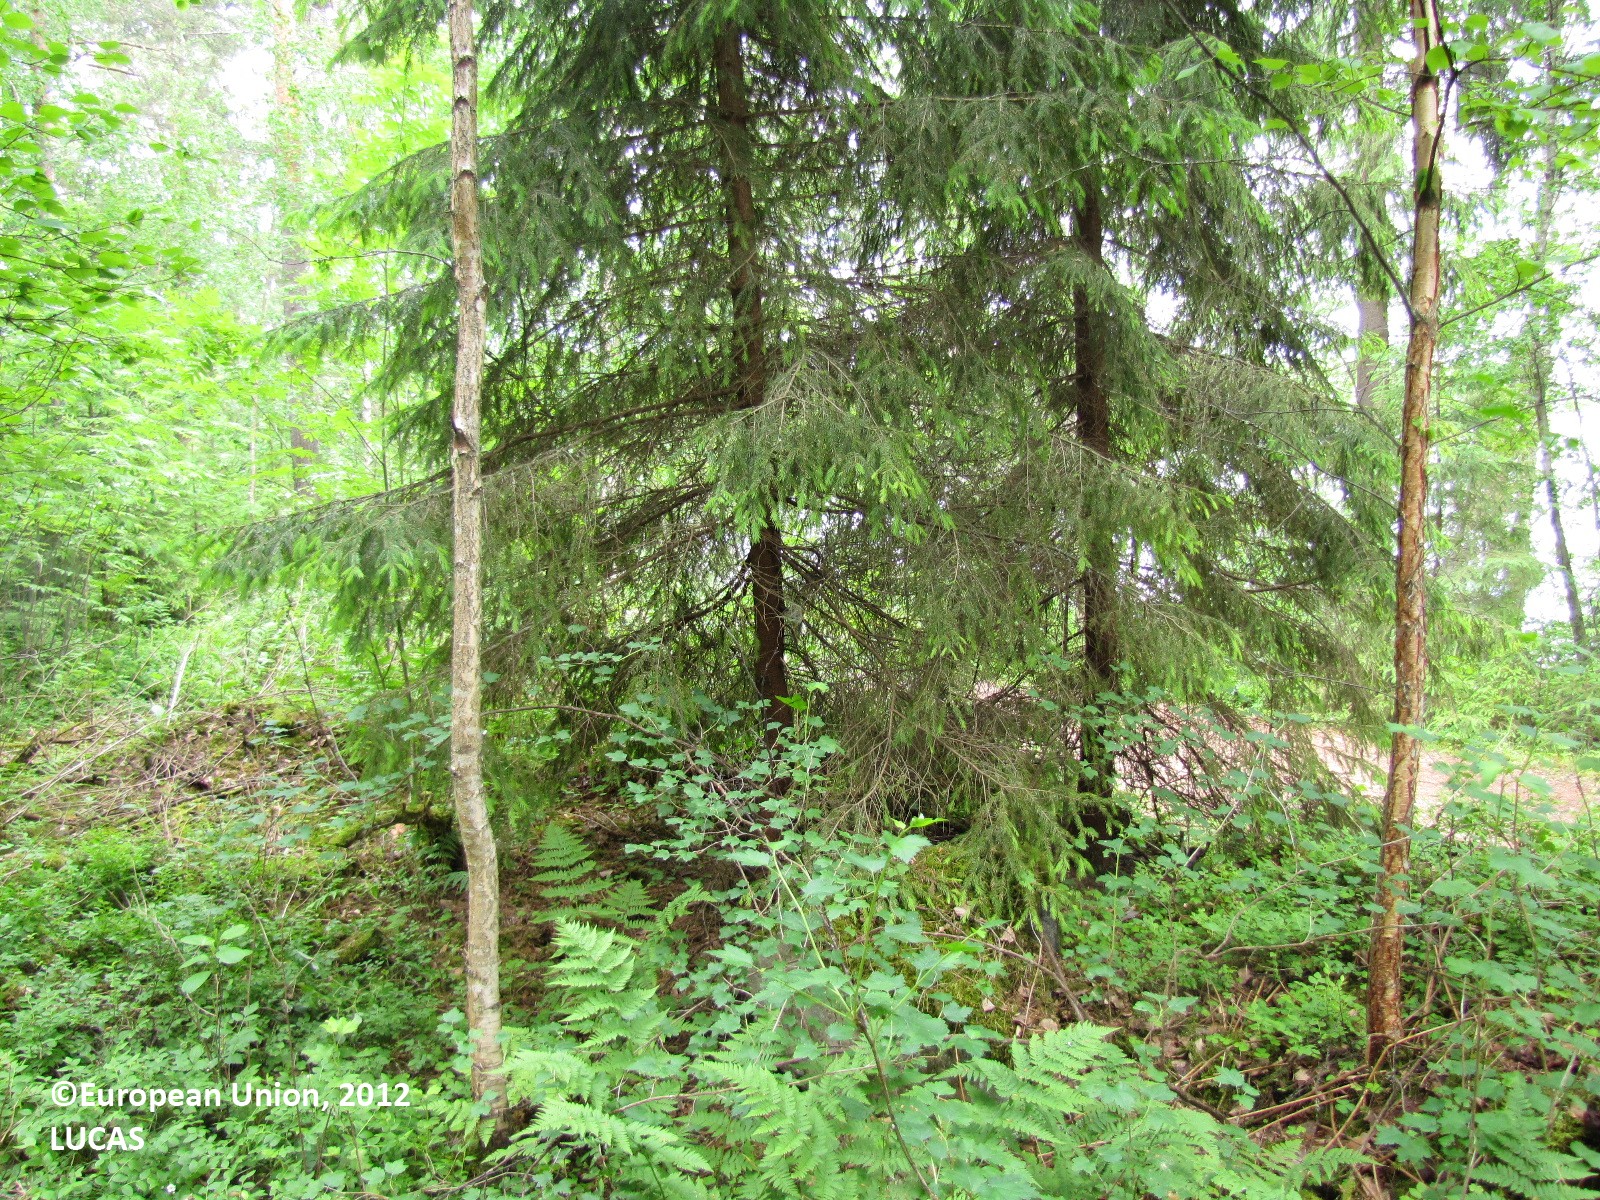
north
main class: Woodland
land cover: Spruce dominated coniferous woodland
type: boreal forest
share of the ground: > 75 %
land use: Forestry
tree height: > 5 m
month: June
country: FI
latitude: 61.2984
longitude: 24.6823
